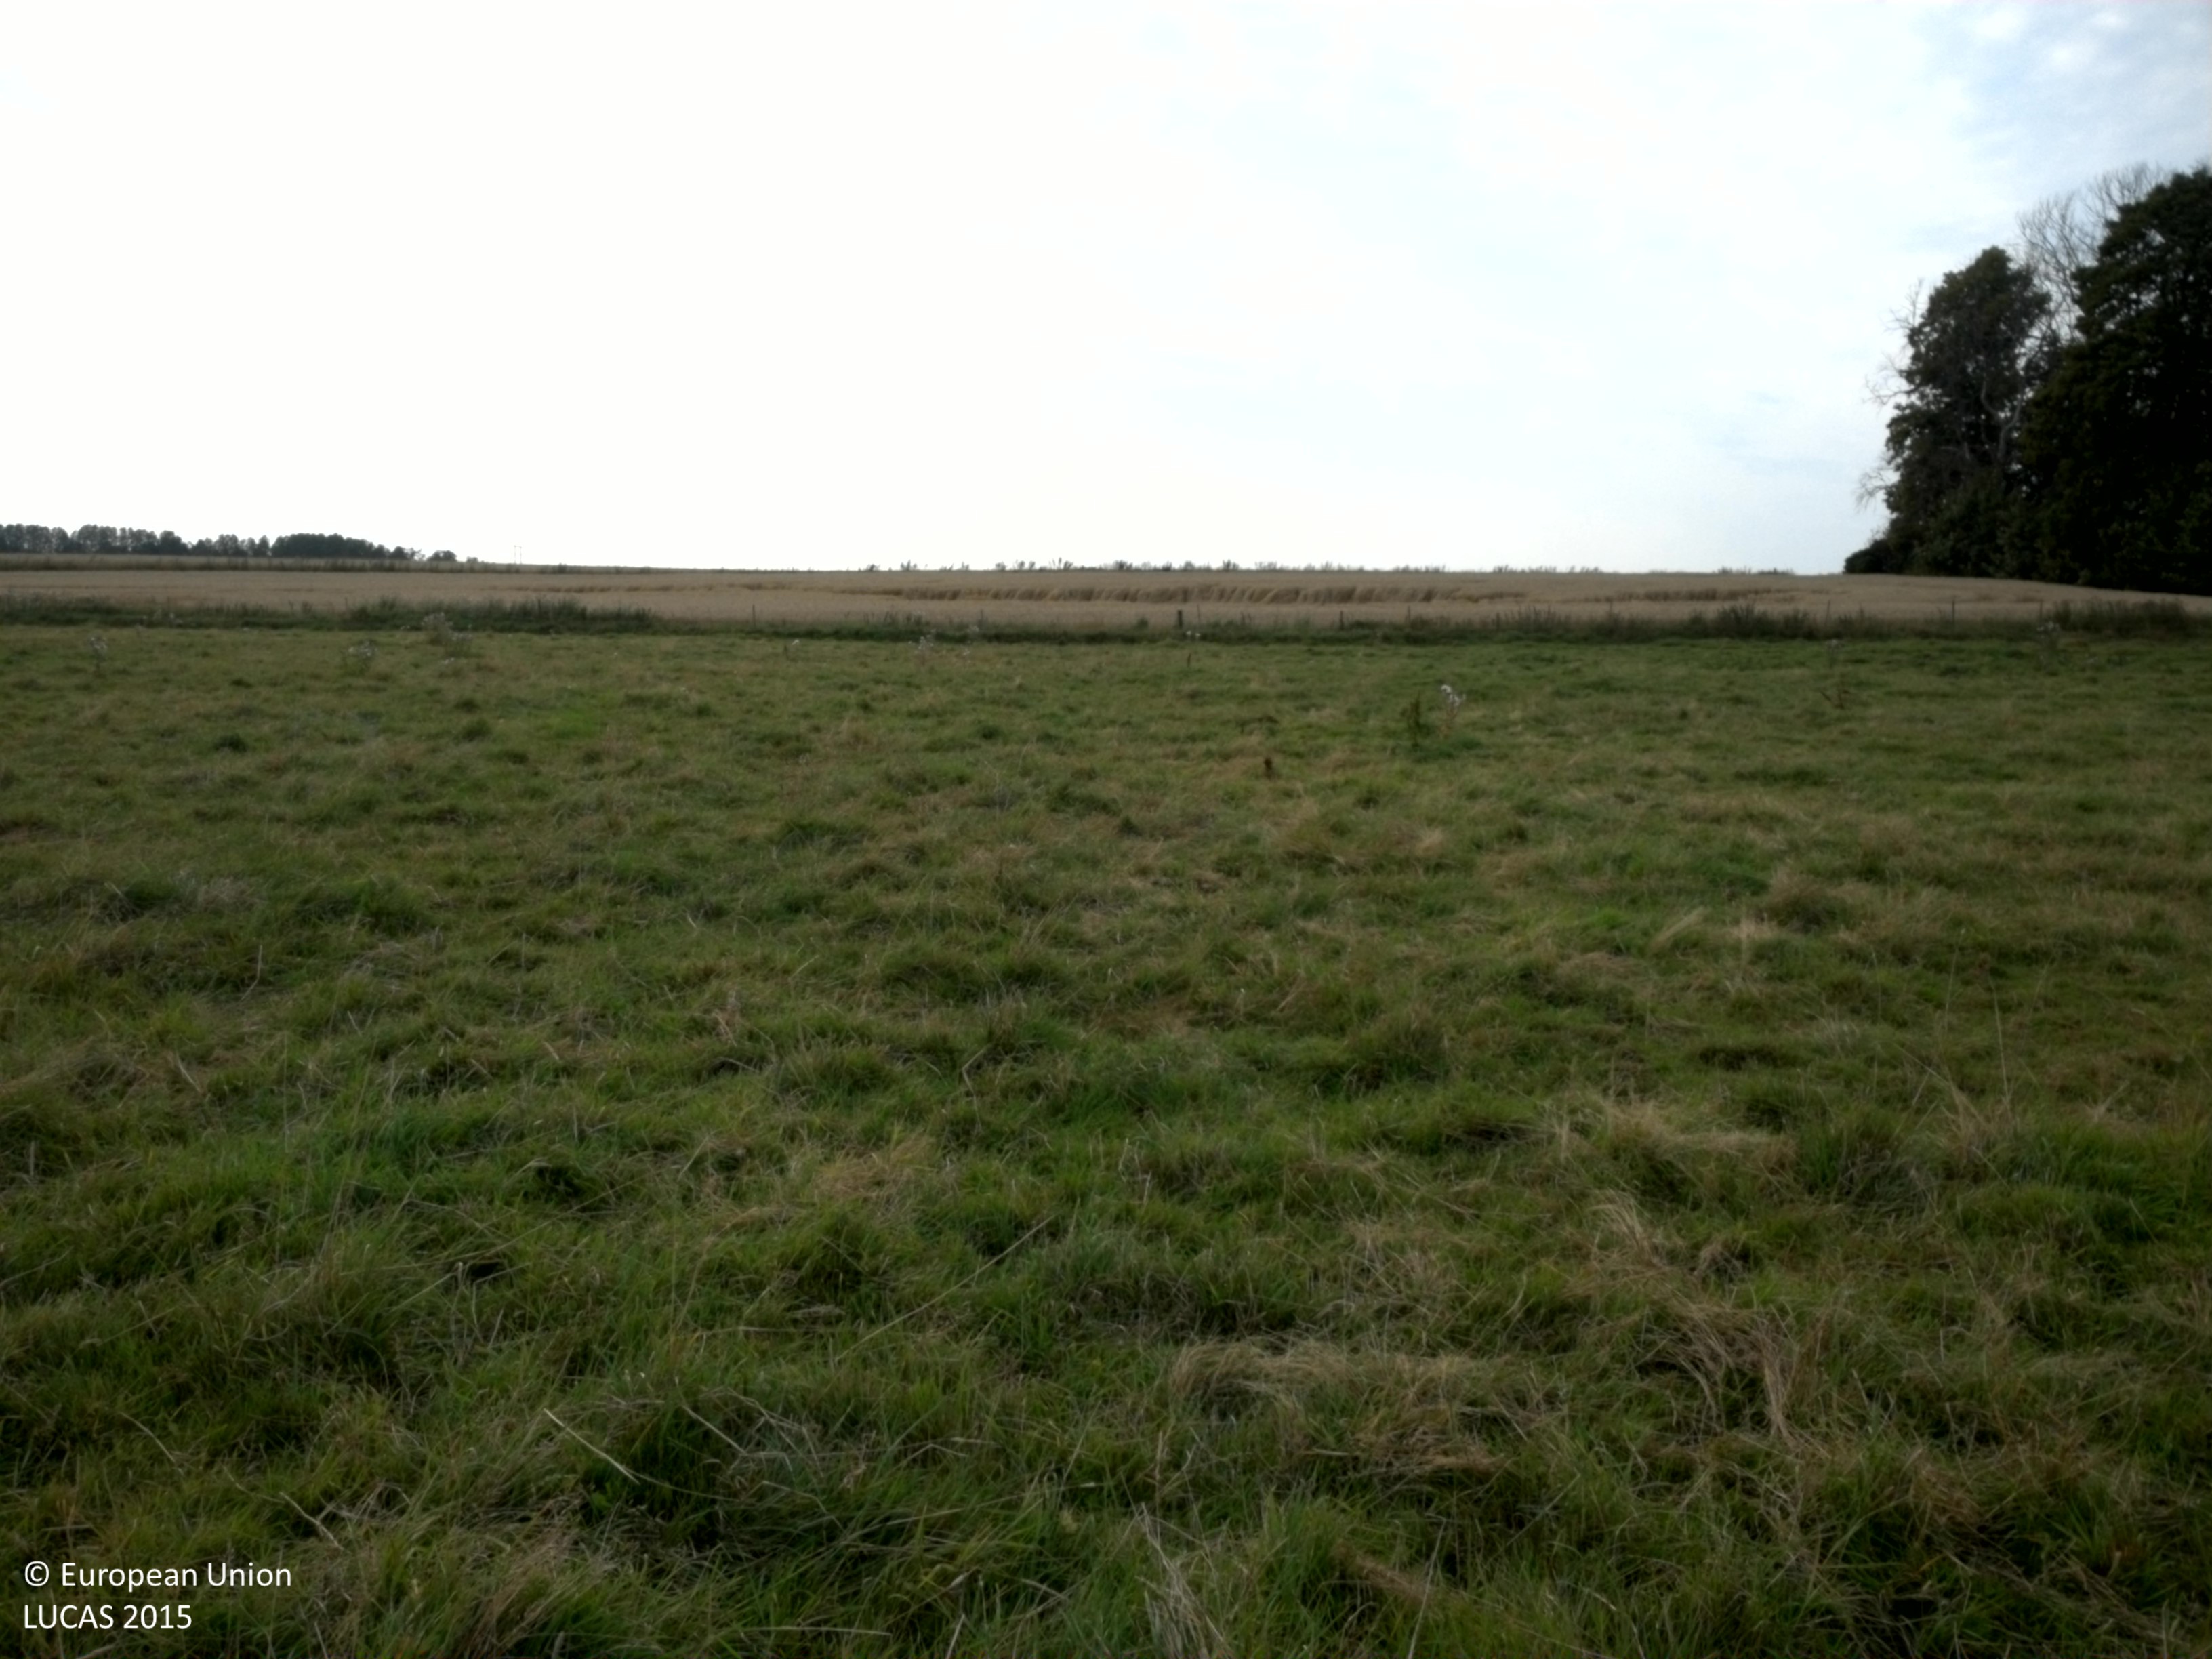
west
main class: Grassland
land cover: Grassland without tree/shrub cover
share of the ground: > 75 %
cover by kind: herbaceous plants 100 %
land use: Agriculture (excluding fallow land and kitchen gardens)
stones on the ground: < 10 %
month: August
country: SE
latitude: 60.0129
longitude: 17.5809
